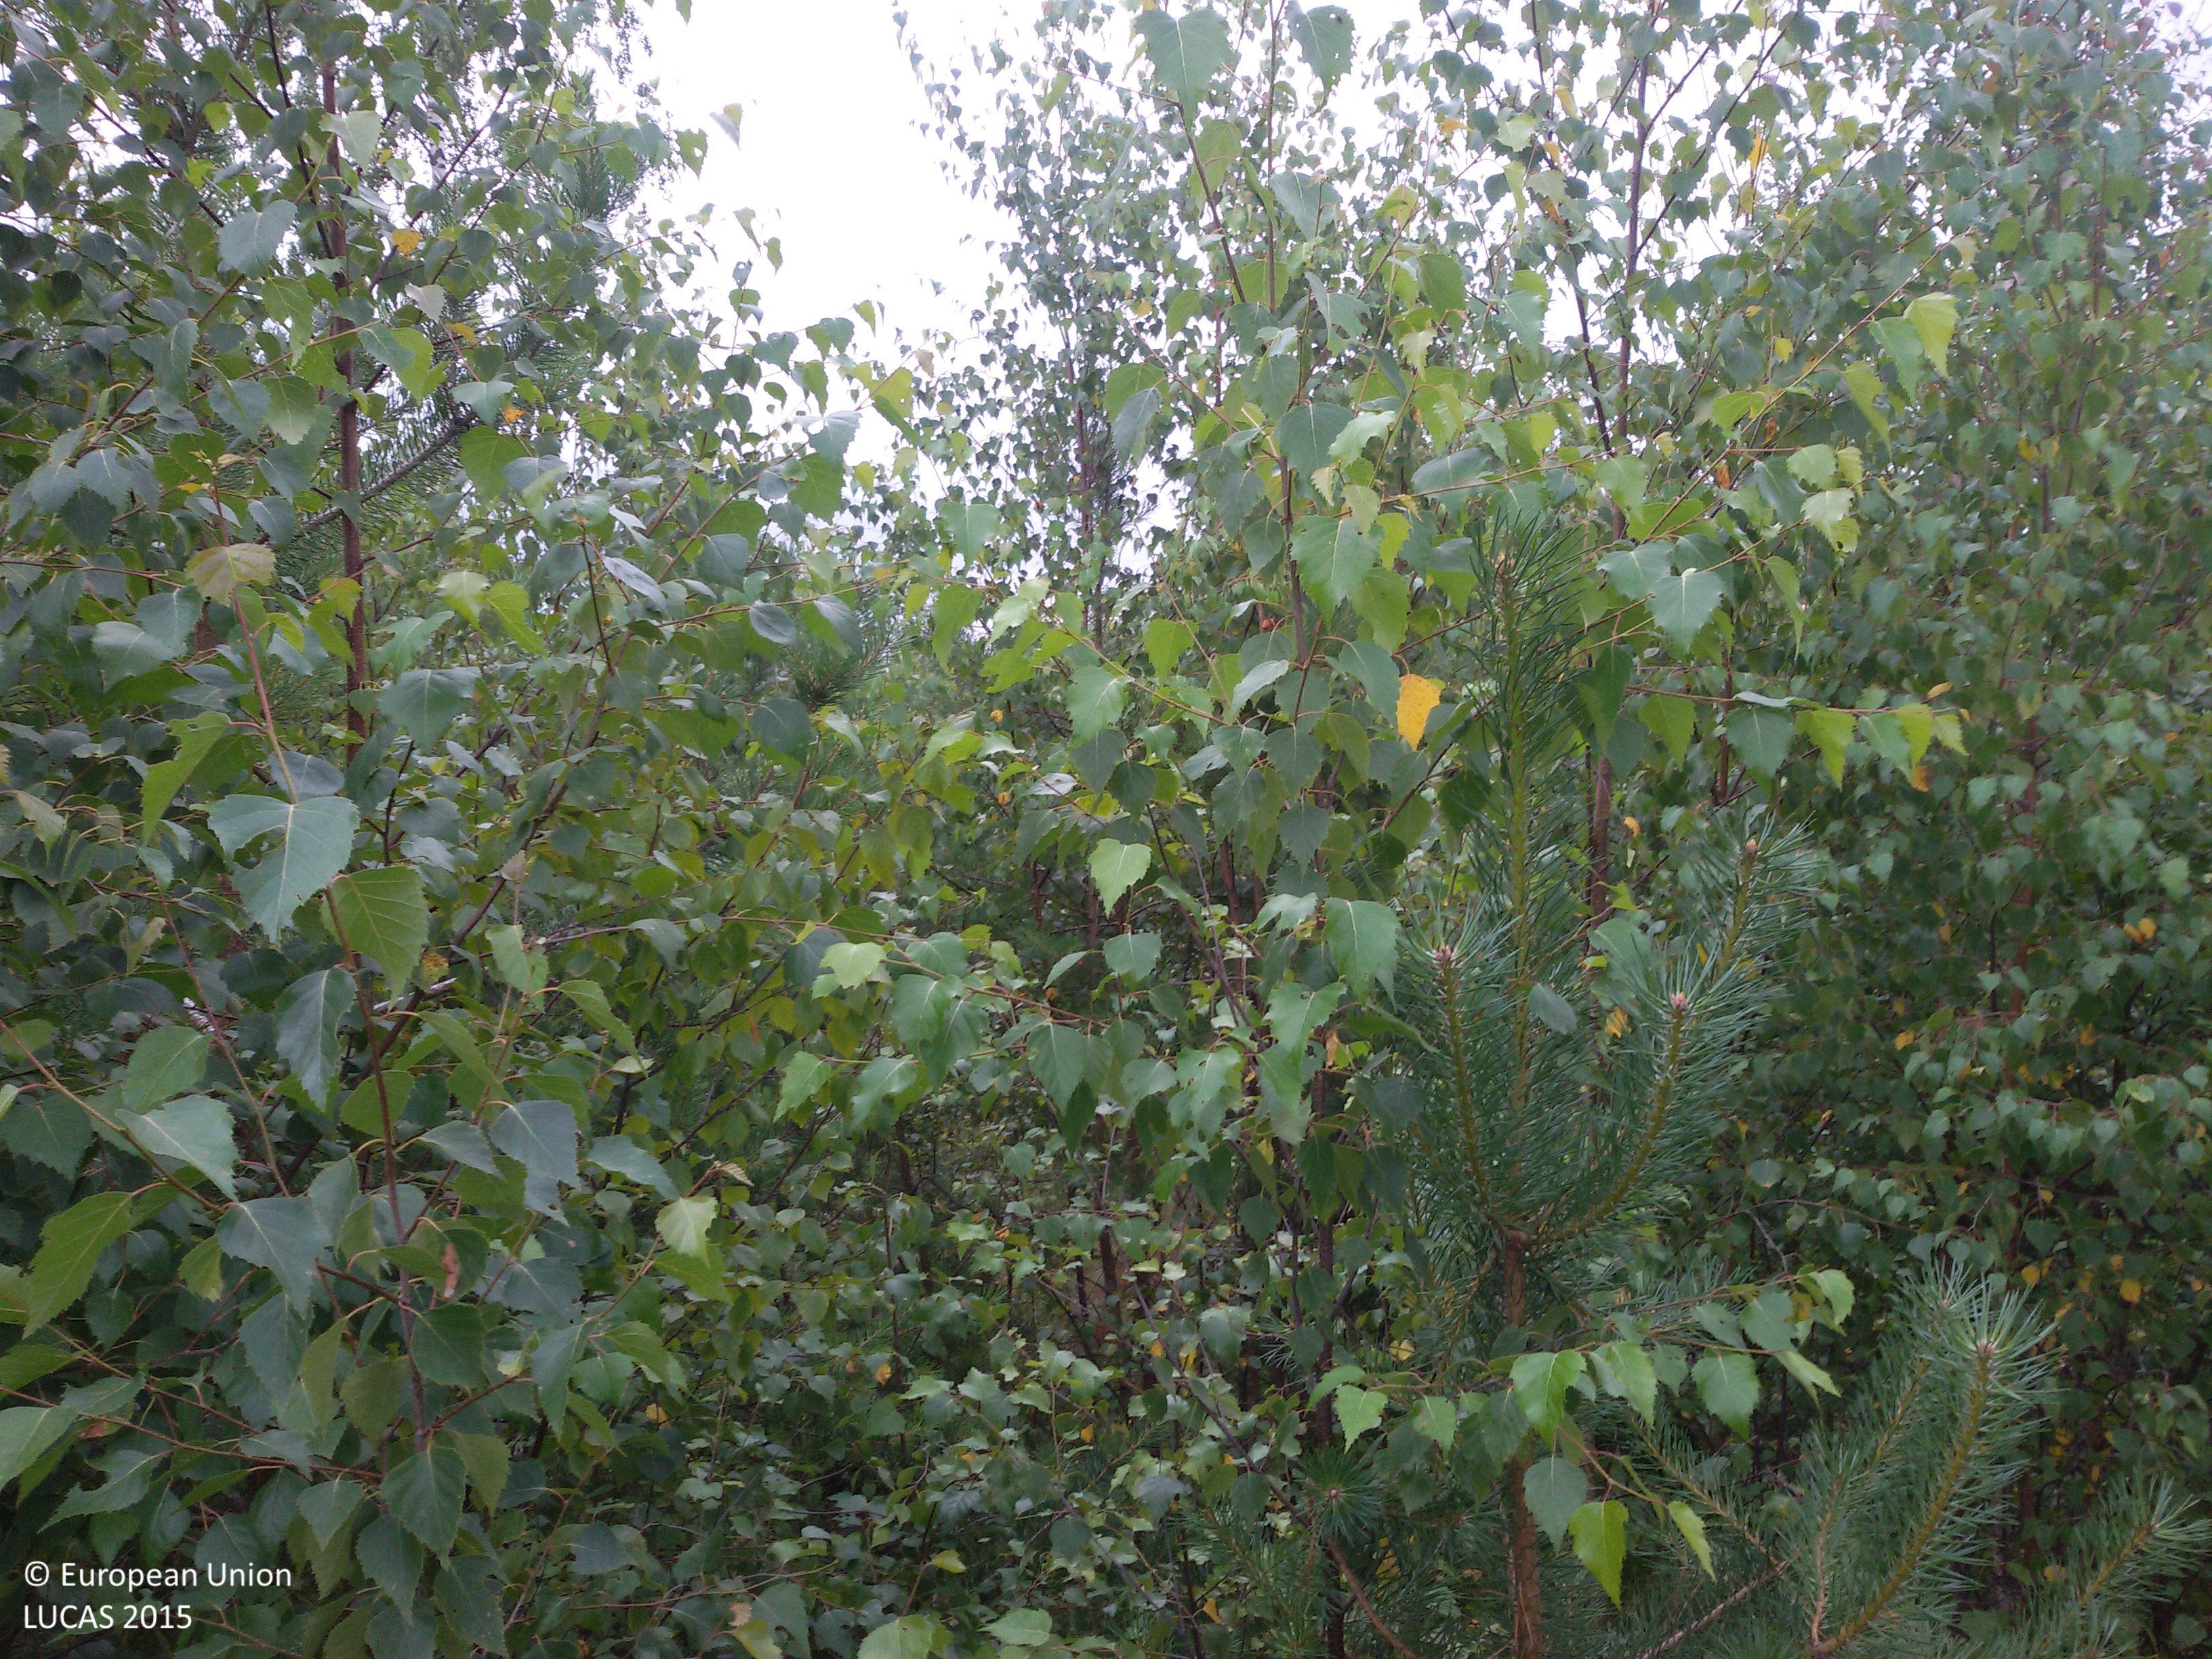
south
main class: Woodland
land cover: Pine dominated mixed woodland
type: boreal forest
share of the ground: > 75 %
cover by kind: broadleaved forest trees 70 %, coniferous forest trees 30 %
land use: Forestry
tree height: < 5 m
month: July
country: SE
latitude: 60.4128
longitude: 16.0345
